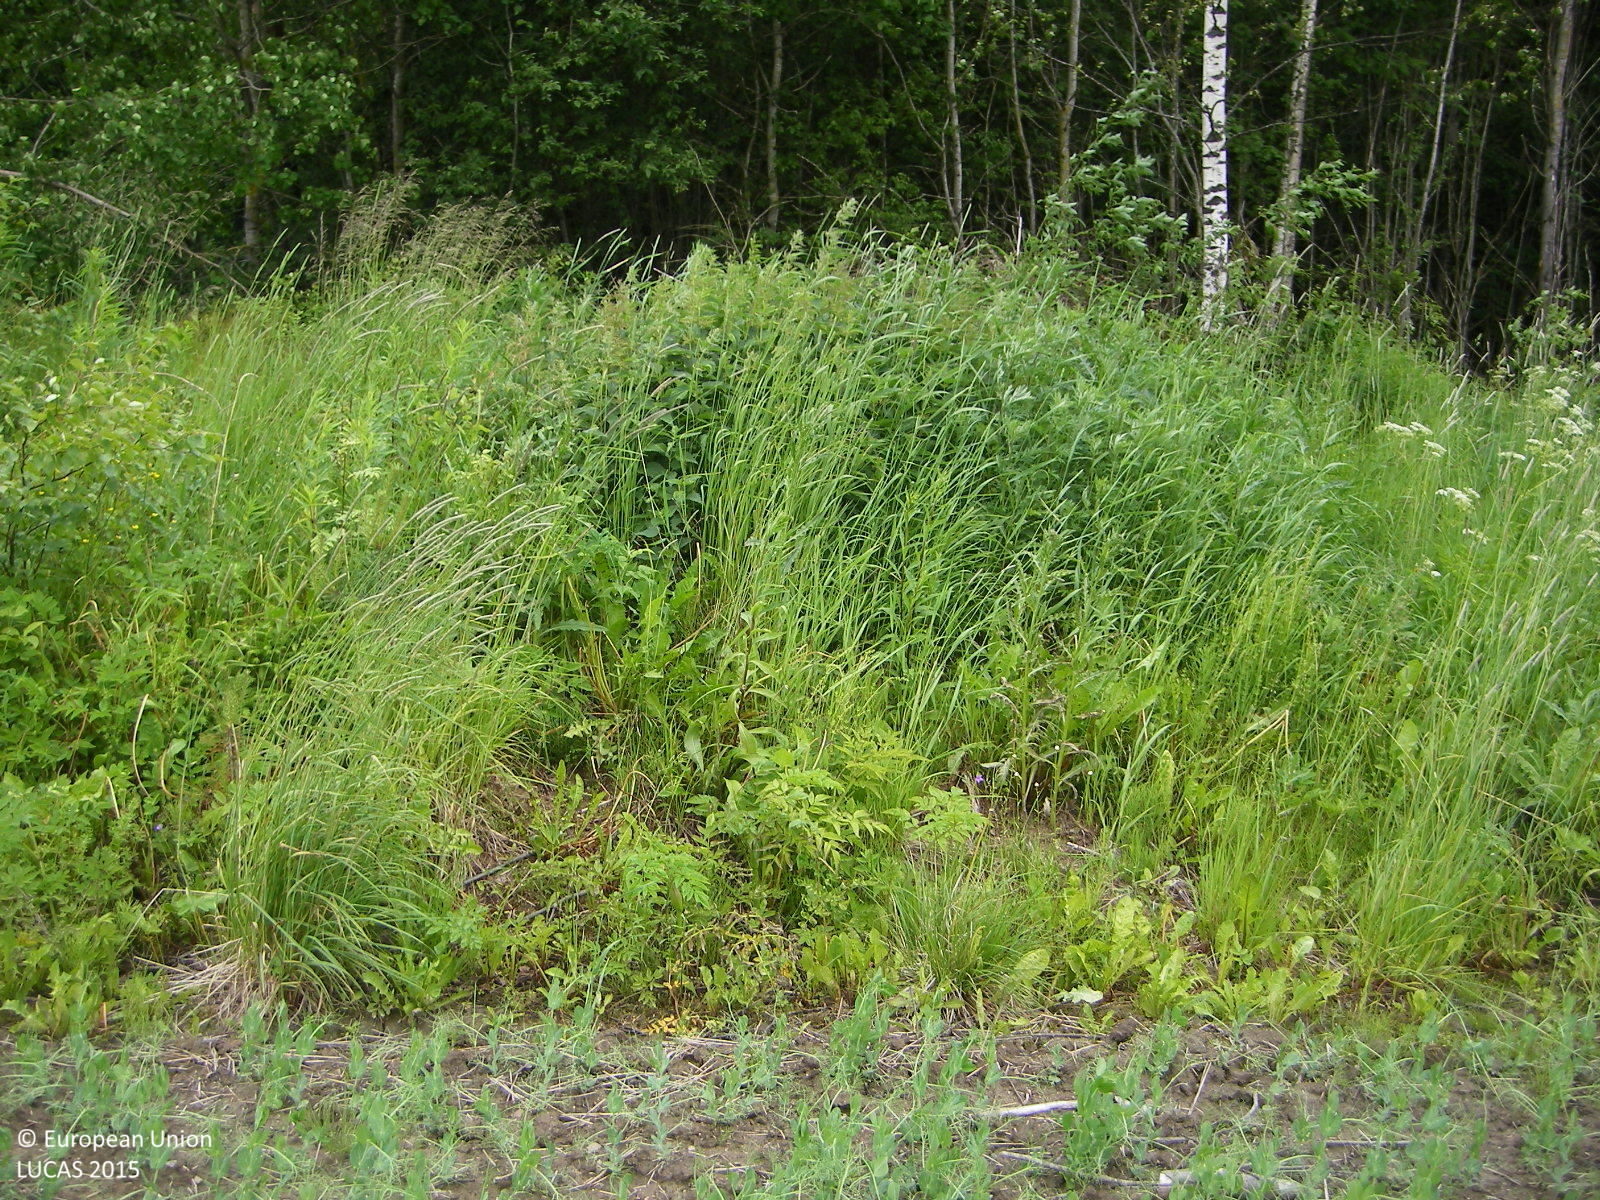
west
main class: Cropland
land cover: Dry pulses
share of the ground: > 75 %
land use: Agriculture (excluding fallow land and kitchen gardens)
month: June
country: FI
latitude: 60.2644
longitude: 23.2604
